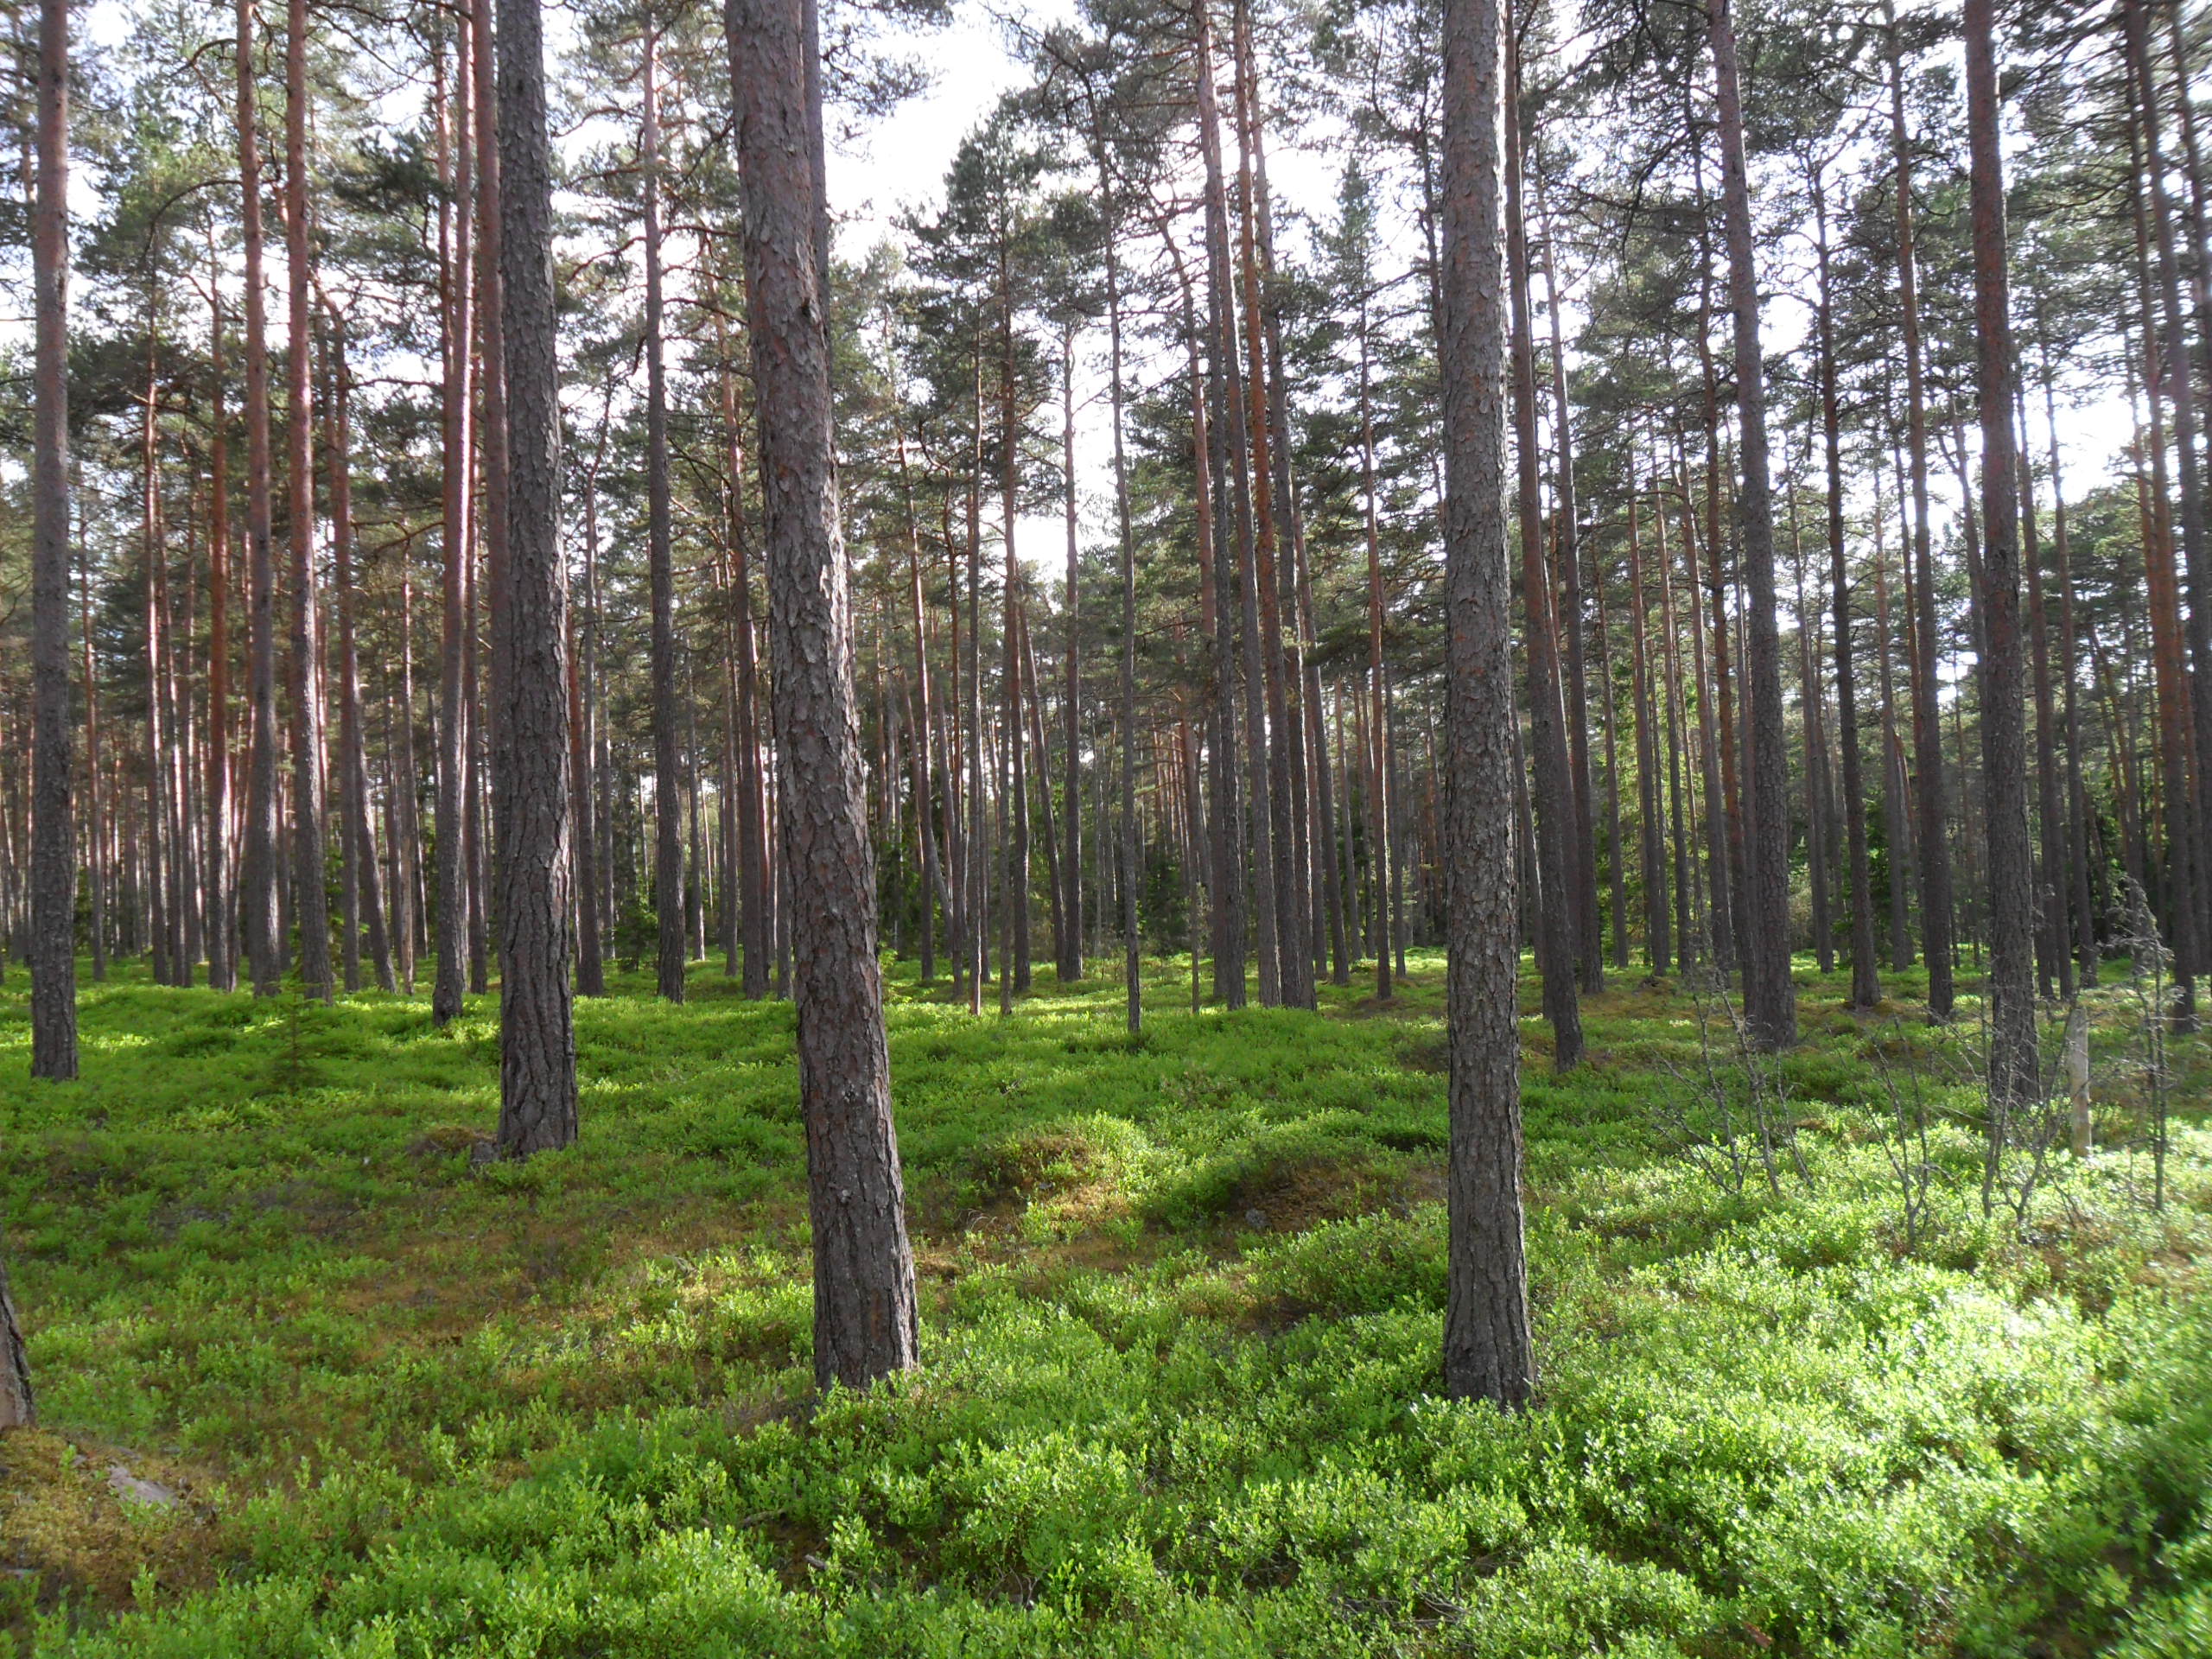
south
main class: Woodland
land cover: Pine dominated coniferous woodland
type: hemiboreal forest and nemoral coniferous forest and mixed broadleaved-coniferous forest
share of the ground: > 75 %
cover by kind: coniferous forest trees 75 %, herbaceous plants 15 %, lichens and mosses 10 %
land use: Amenities, museums, leisure
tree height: > 5 m
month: June
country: LV
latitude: 57.6624
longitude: 22.5742
